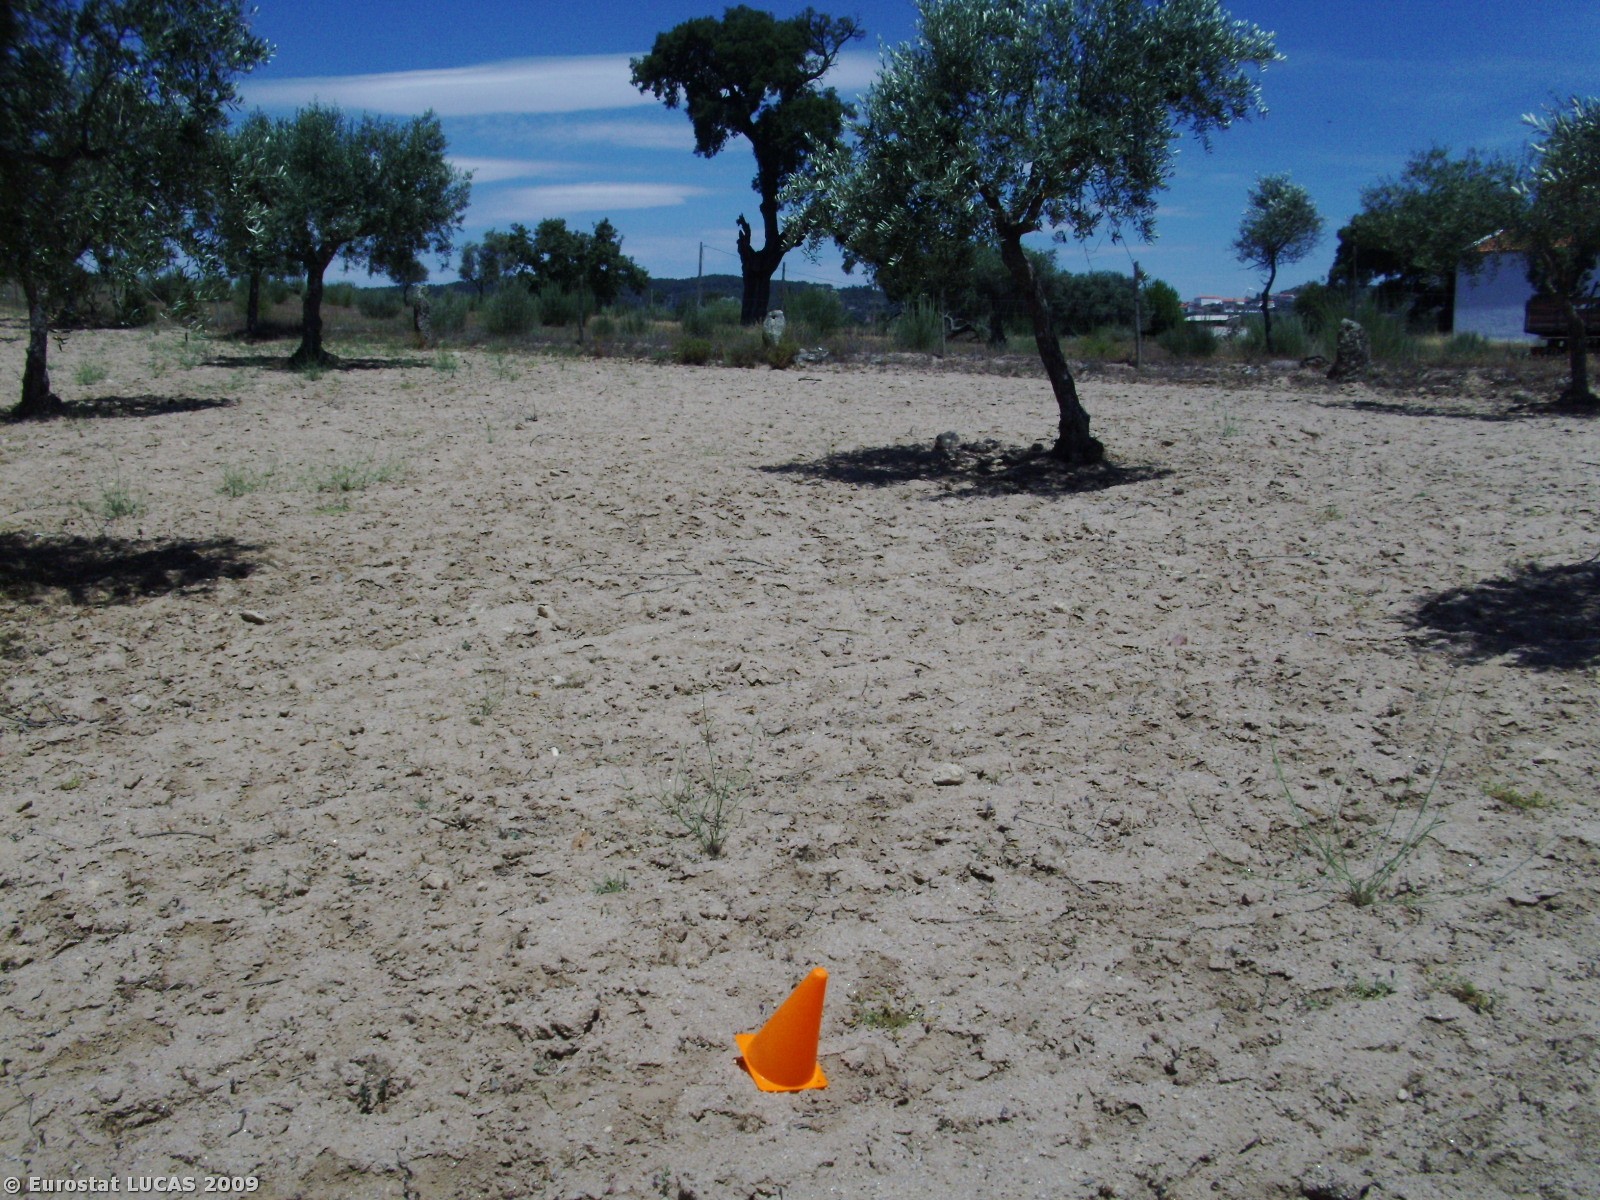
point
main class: Cropland
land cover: Olive groves
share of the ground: 10 - 25 %
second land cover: Bare land
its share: > 75 %
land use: Agriculture (excluding fallow land and kitchen gardens)
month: June
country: PT
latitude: 40.1418
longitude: -7.1751
